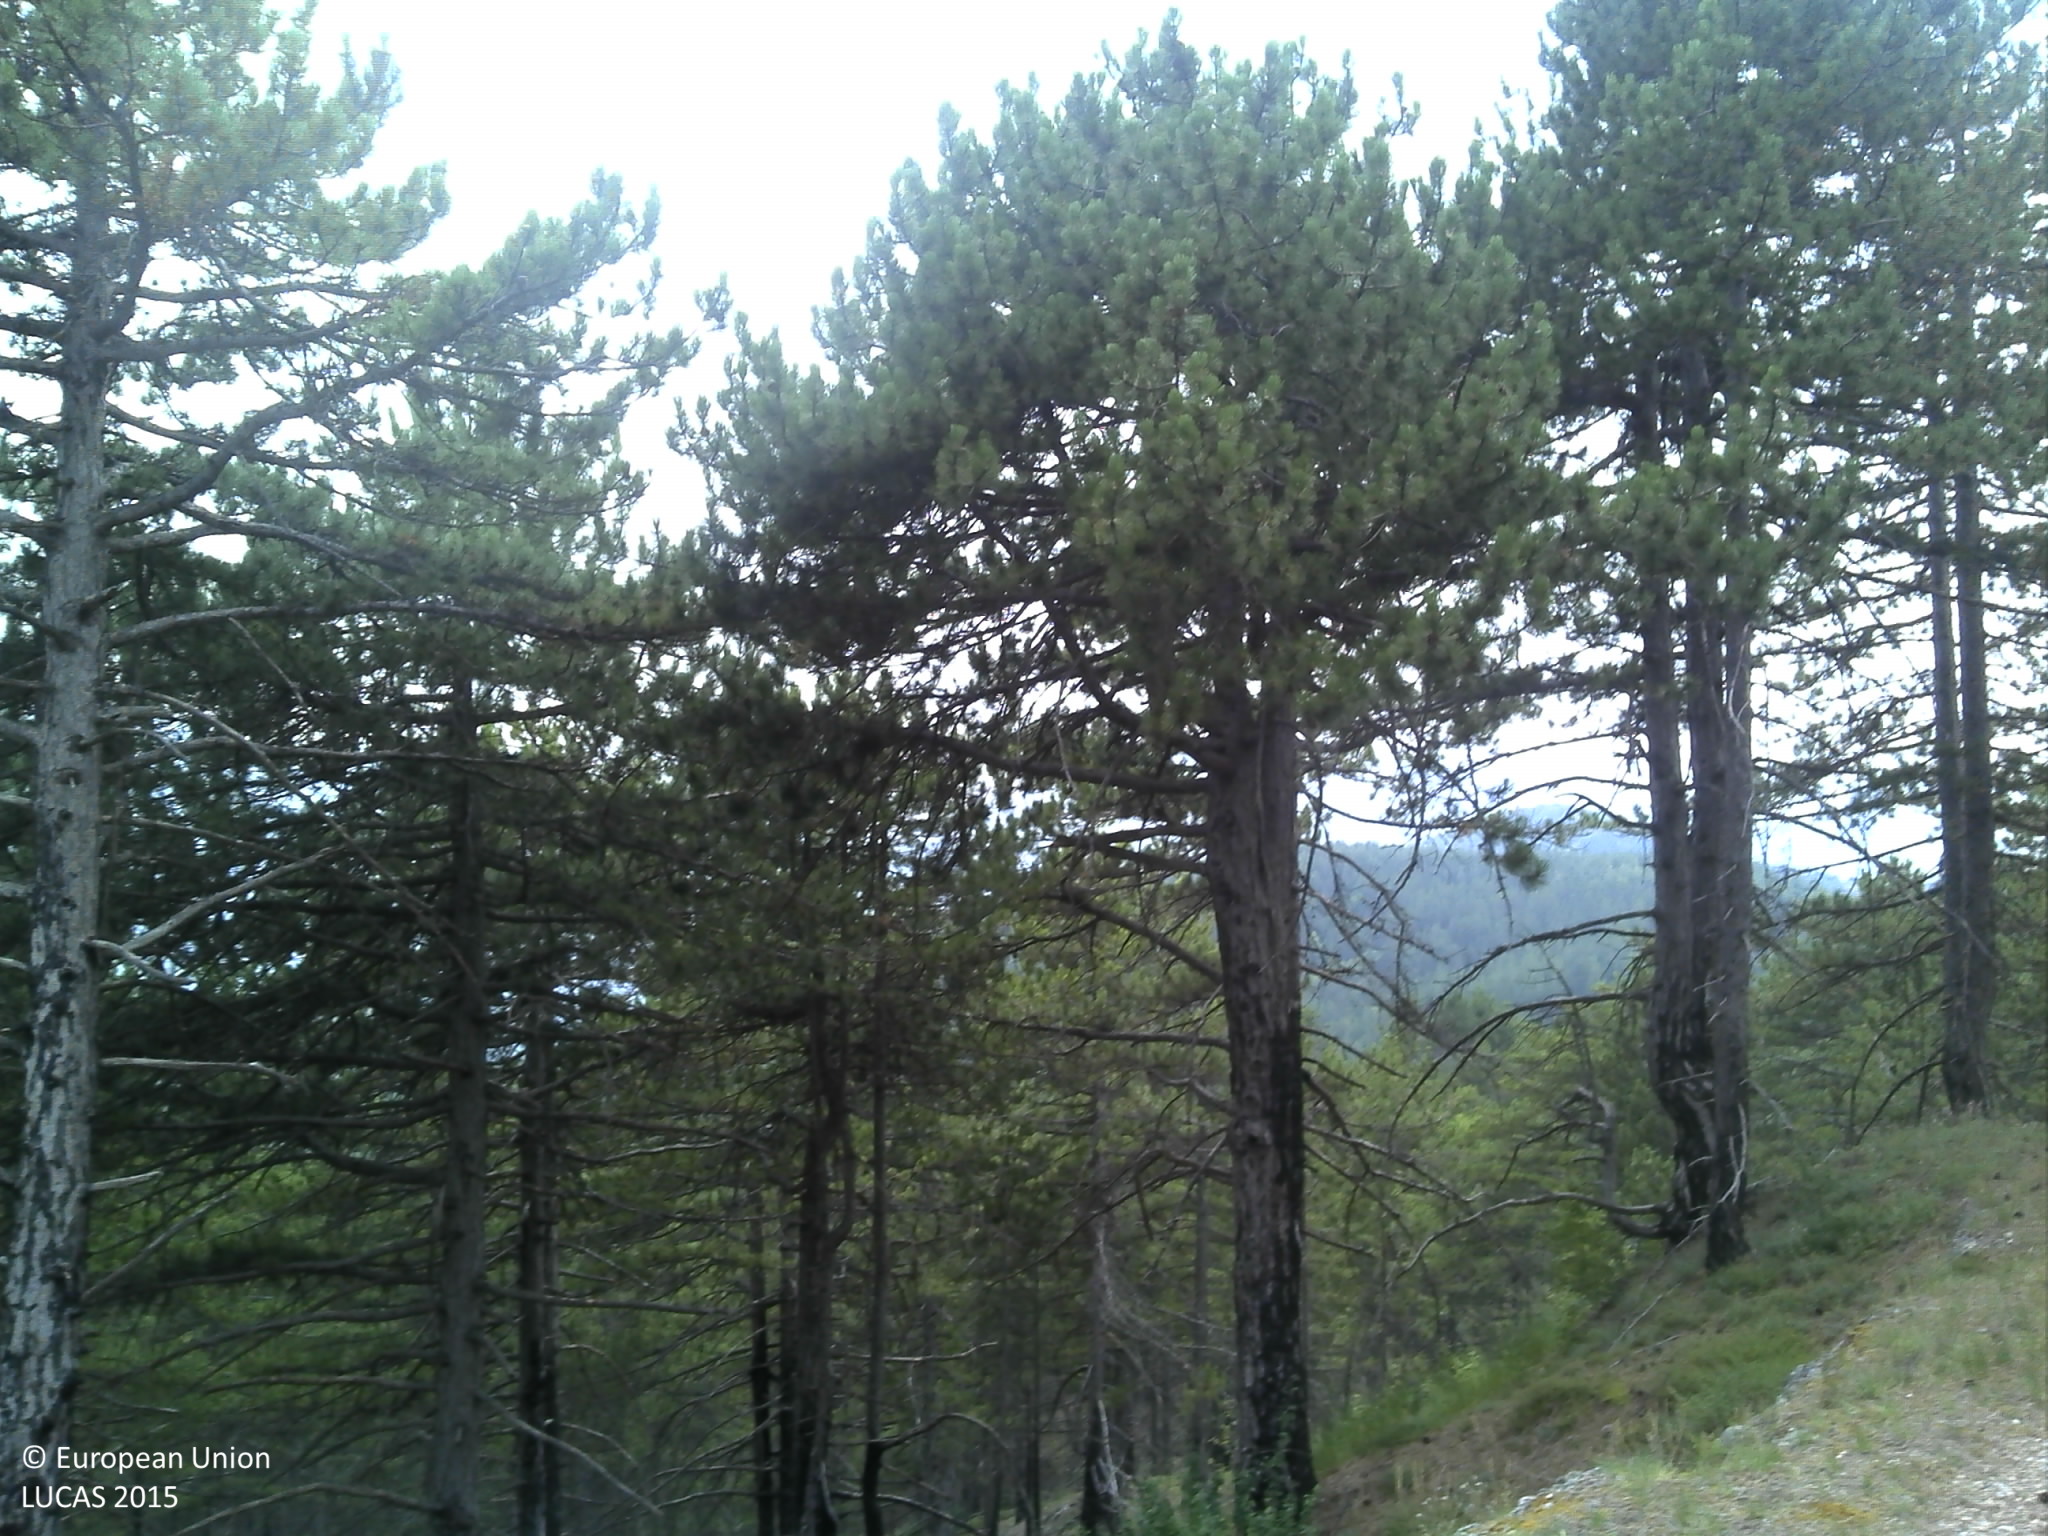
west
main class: Woodland
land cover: Pine dominated coniferous woodland
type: coniferous forest of the mediterranean region
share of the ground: > 75 %
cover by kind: coniferous forest trees 75 %, herbaceous plants 20 %, shrubs 5 %
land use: Semi-natural and natural areas not in use
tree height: > 5 m
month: July
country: HR
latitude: 44.3488
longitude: 16.1530
